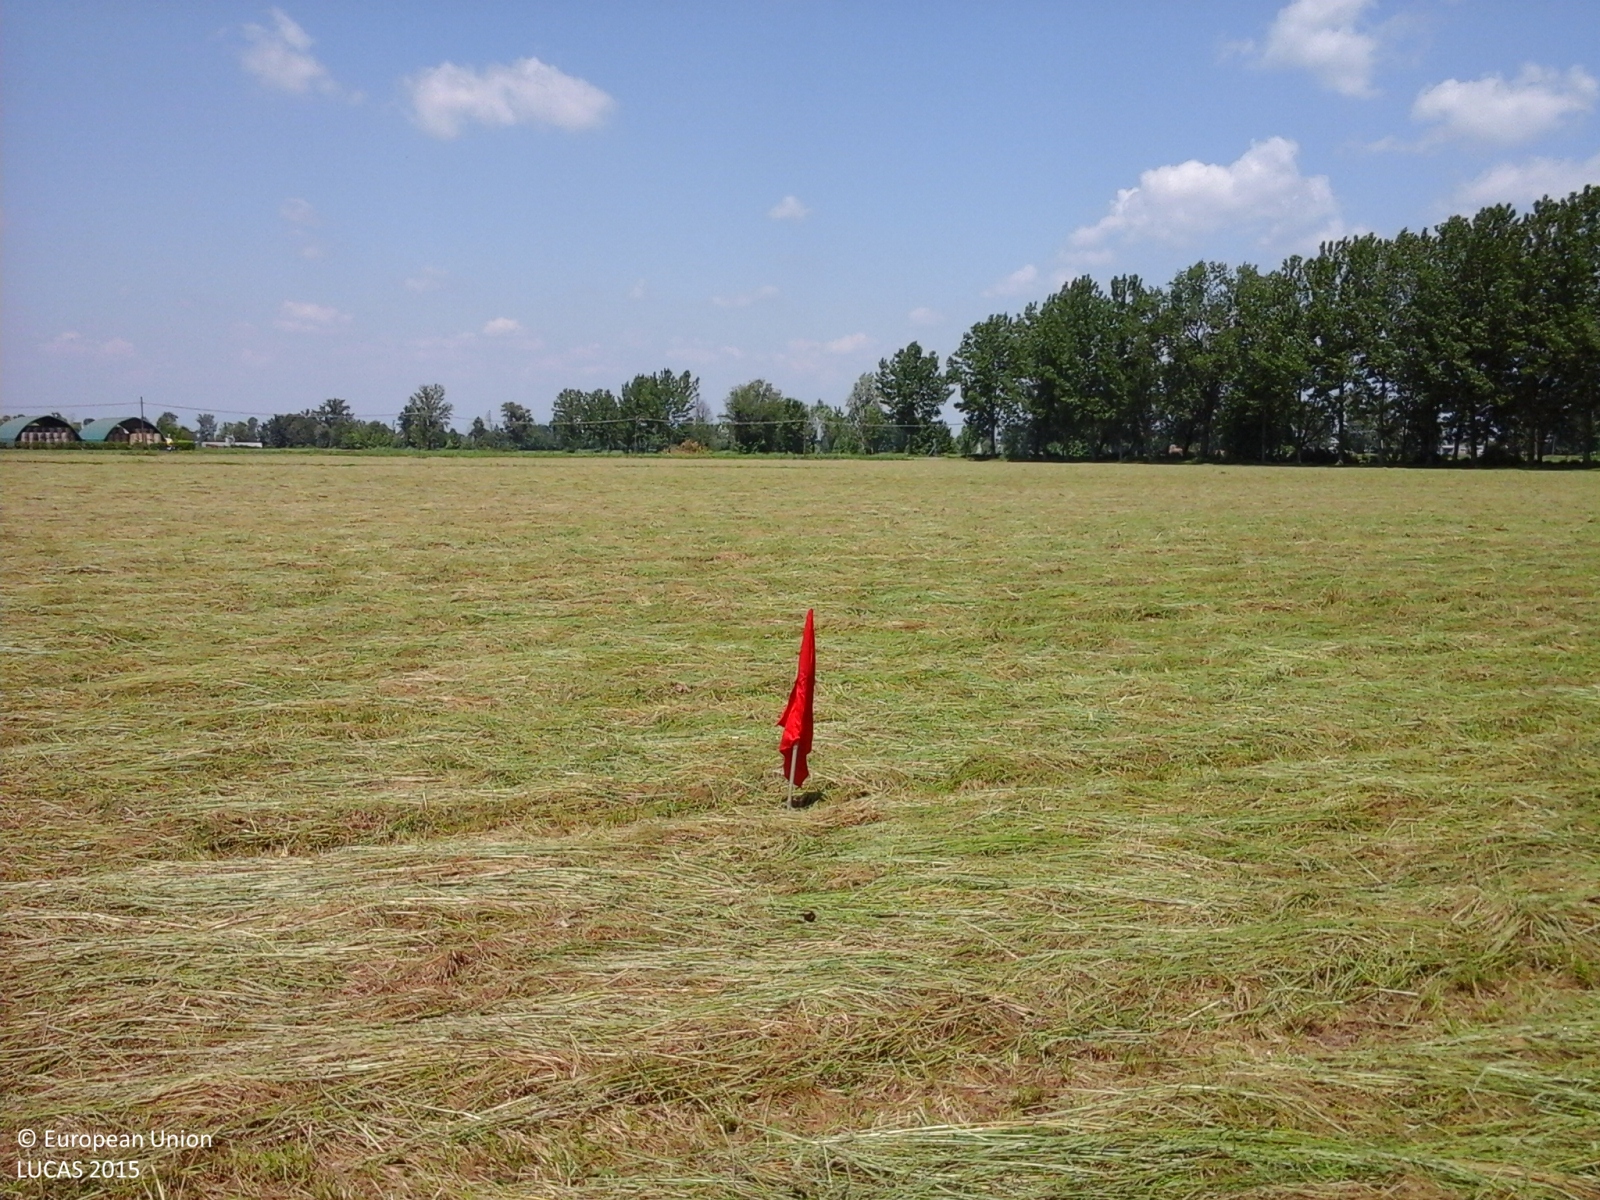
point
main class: Cropland
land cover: Temporary grasslands
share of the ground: > 75 %
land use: Agriculture (excluding fallow land and kitchen gardens)
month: May
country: IT
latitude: 45.3958
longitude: 9.6812
